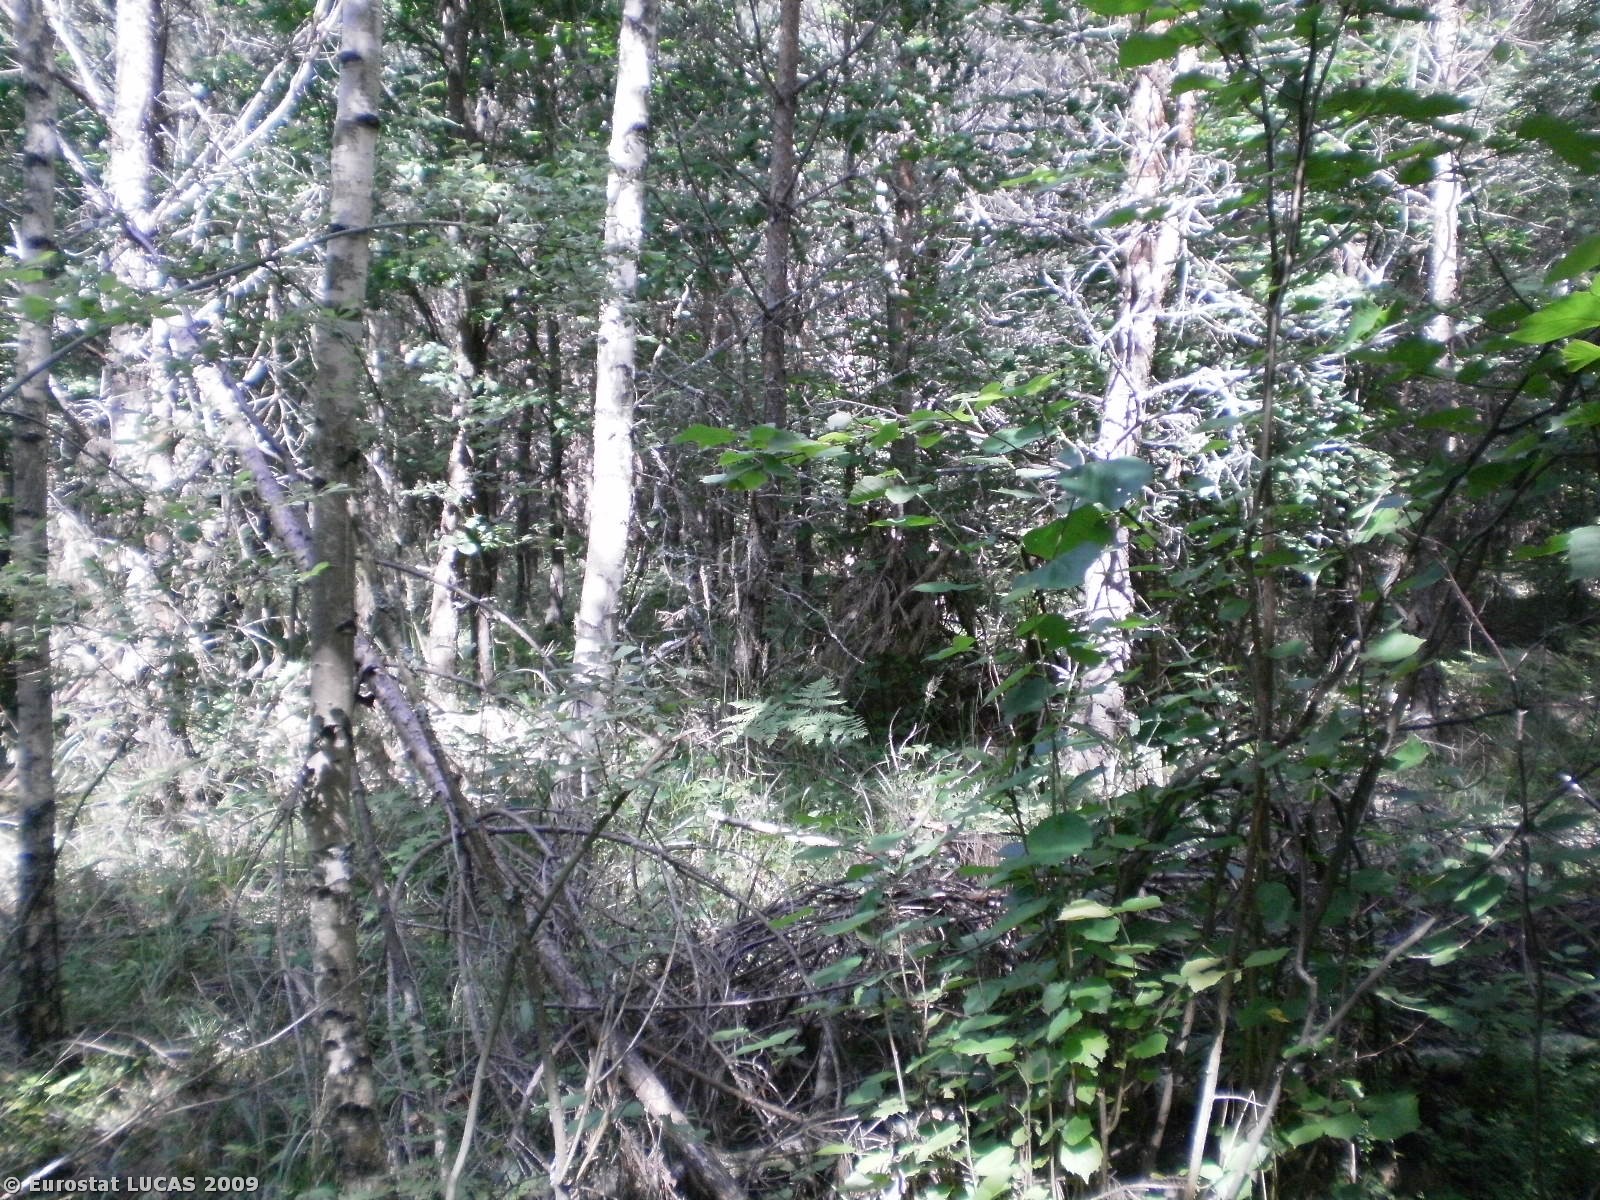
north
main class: Woodland
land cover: Mixed woodland
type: hemiboreal forest and nemoral coniferous forest and mixed broadleaved-coniferous forest
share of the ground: > 75 %
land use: Forestry
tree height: > 5 m
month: July
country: PL
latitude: 53.4136
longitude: 20.5239
